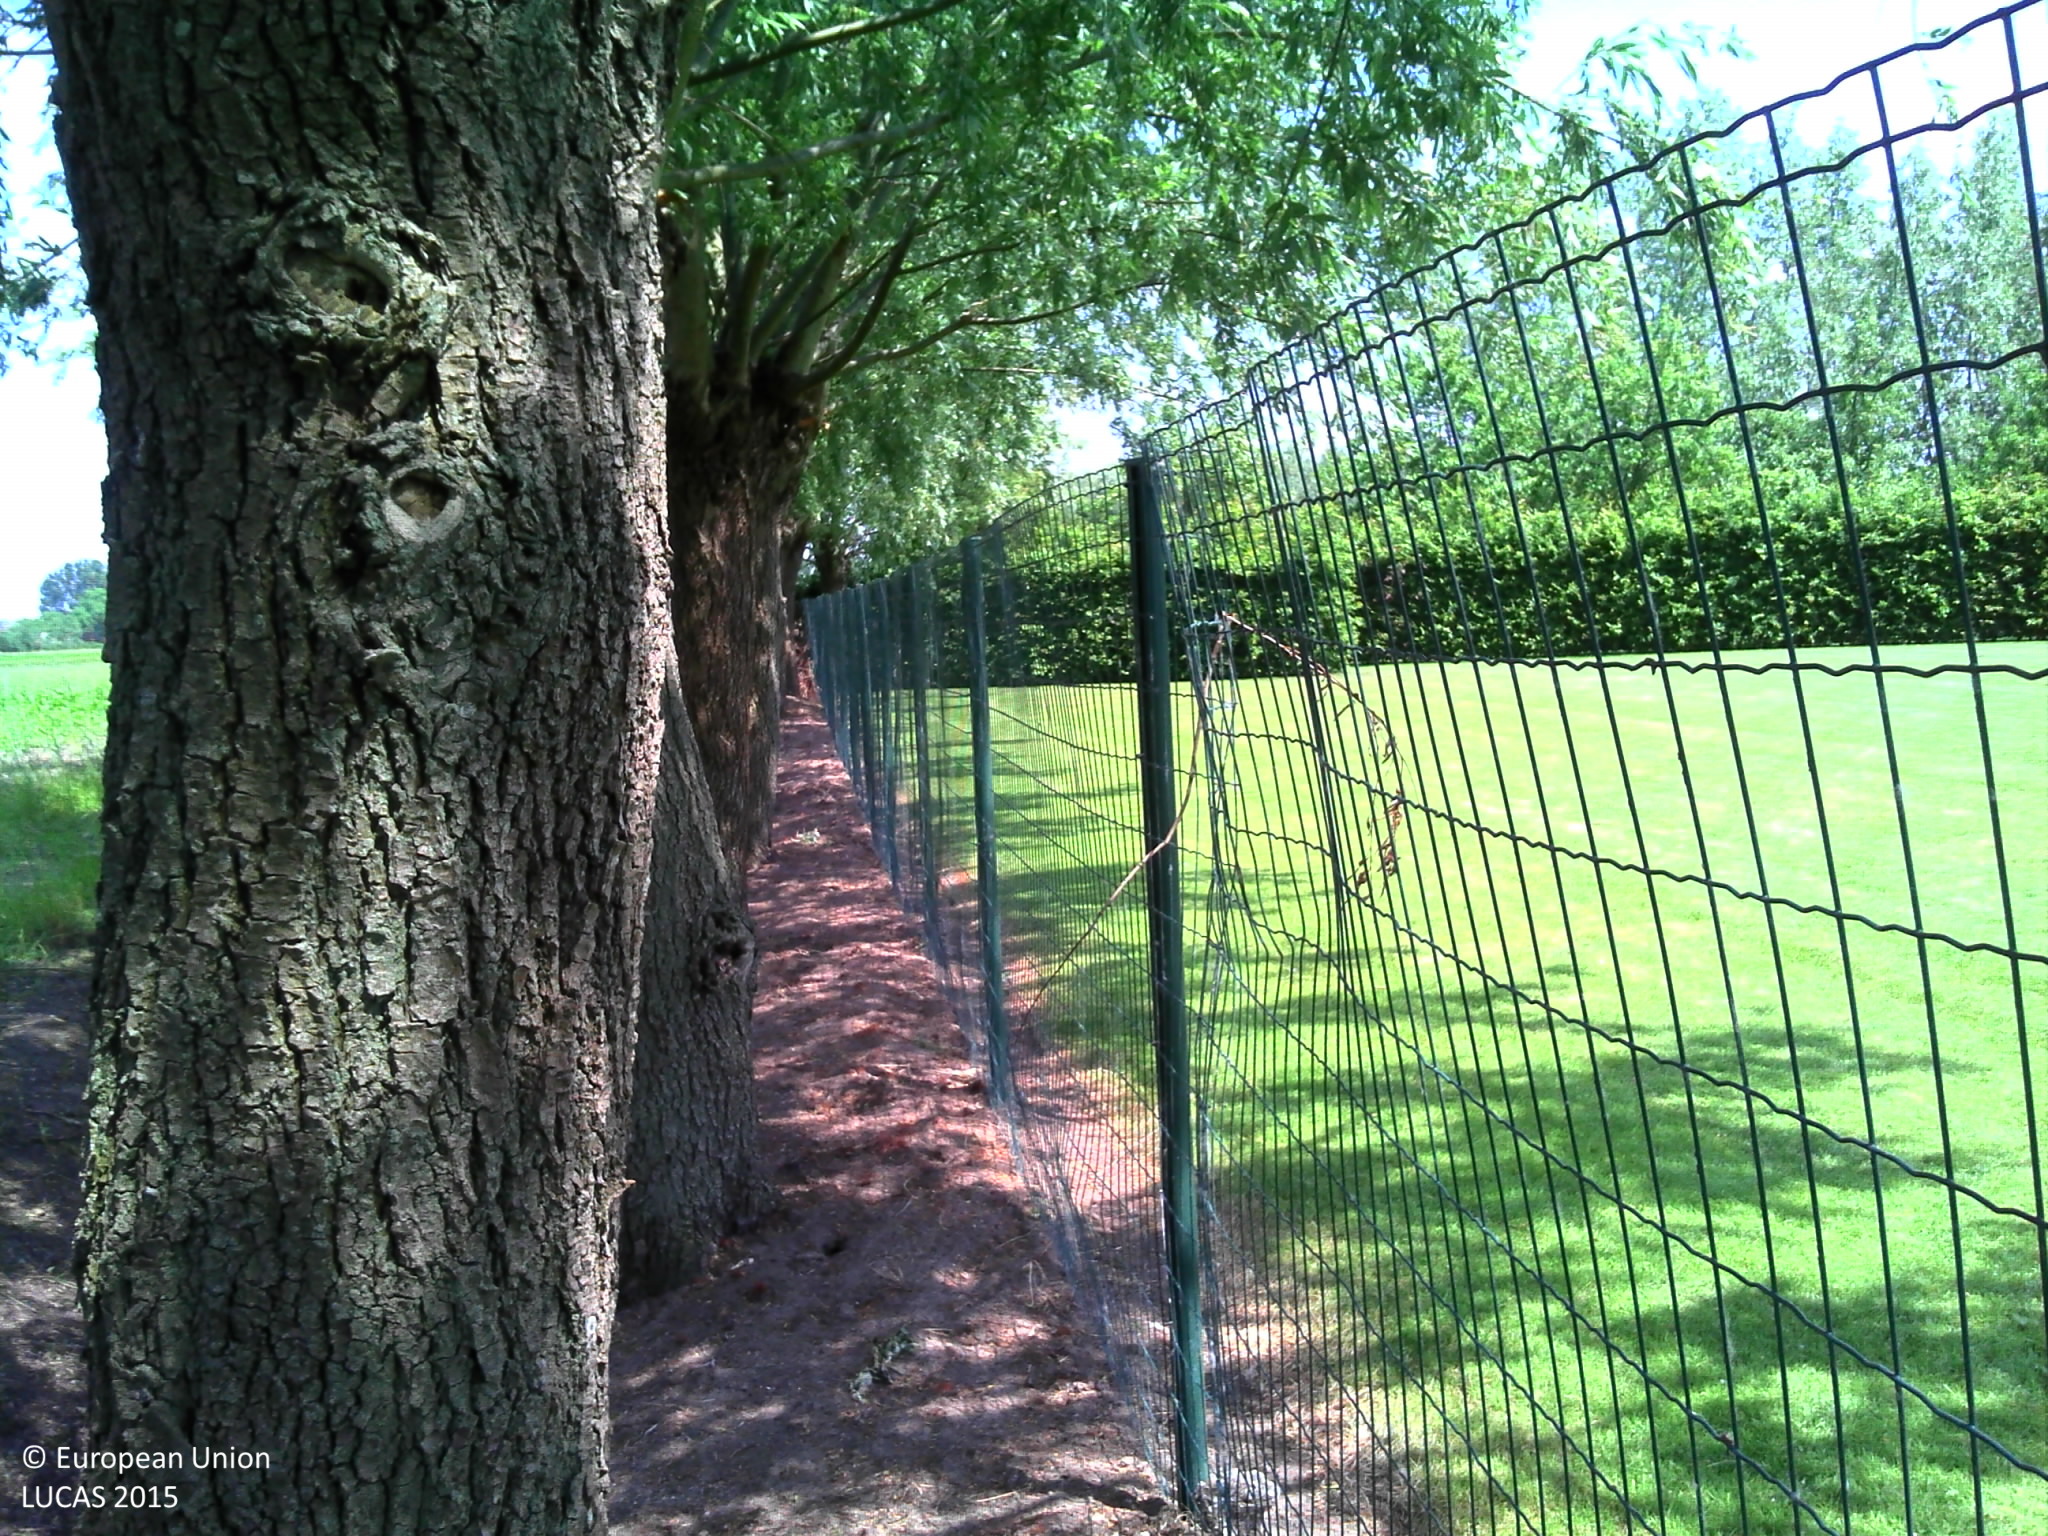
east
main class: Grassland
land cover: Grassland without tree/shrub cover
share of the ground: > 75 %
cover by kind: herbaceous plants 100 %
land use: Residential
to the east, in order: Grassland without tree/shrub cover; Managed hedges; Grassland with sparse tree/shrub cover; Lines of trees; Fences; Tracks; Maize; Ditches and canals; Maize
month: June
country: BE
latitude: 51.0489
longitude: 3.9027
